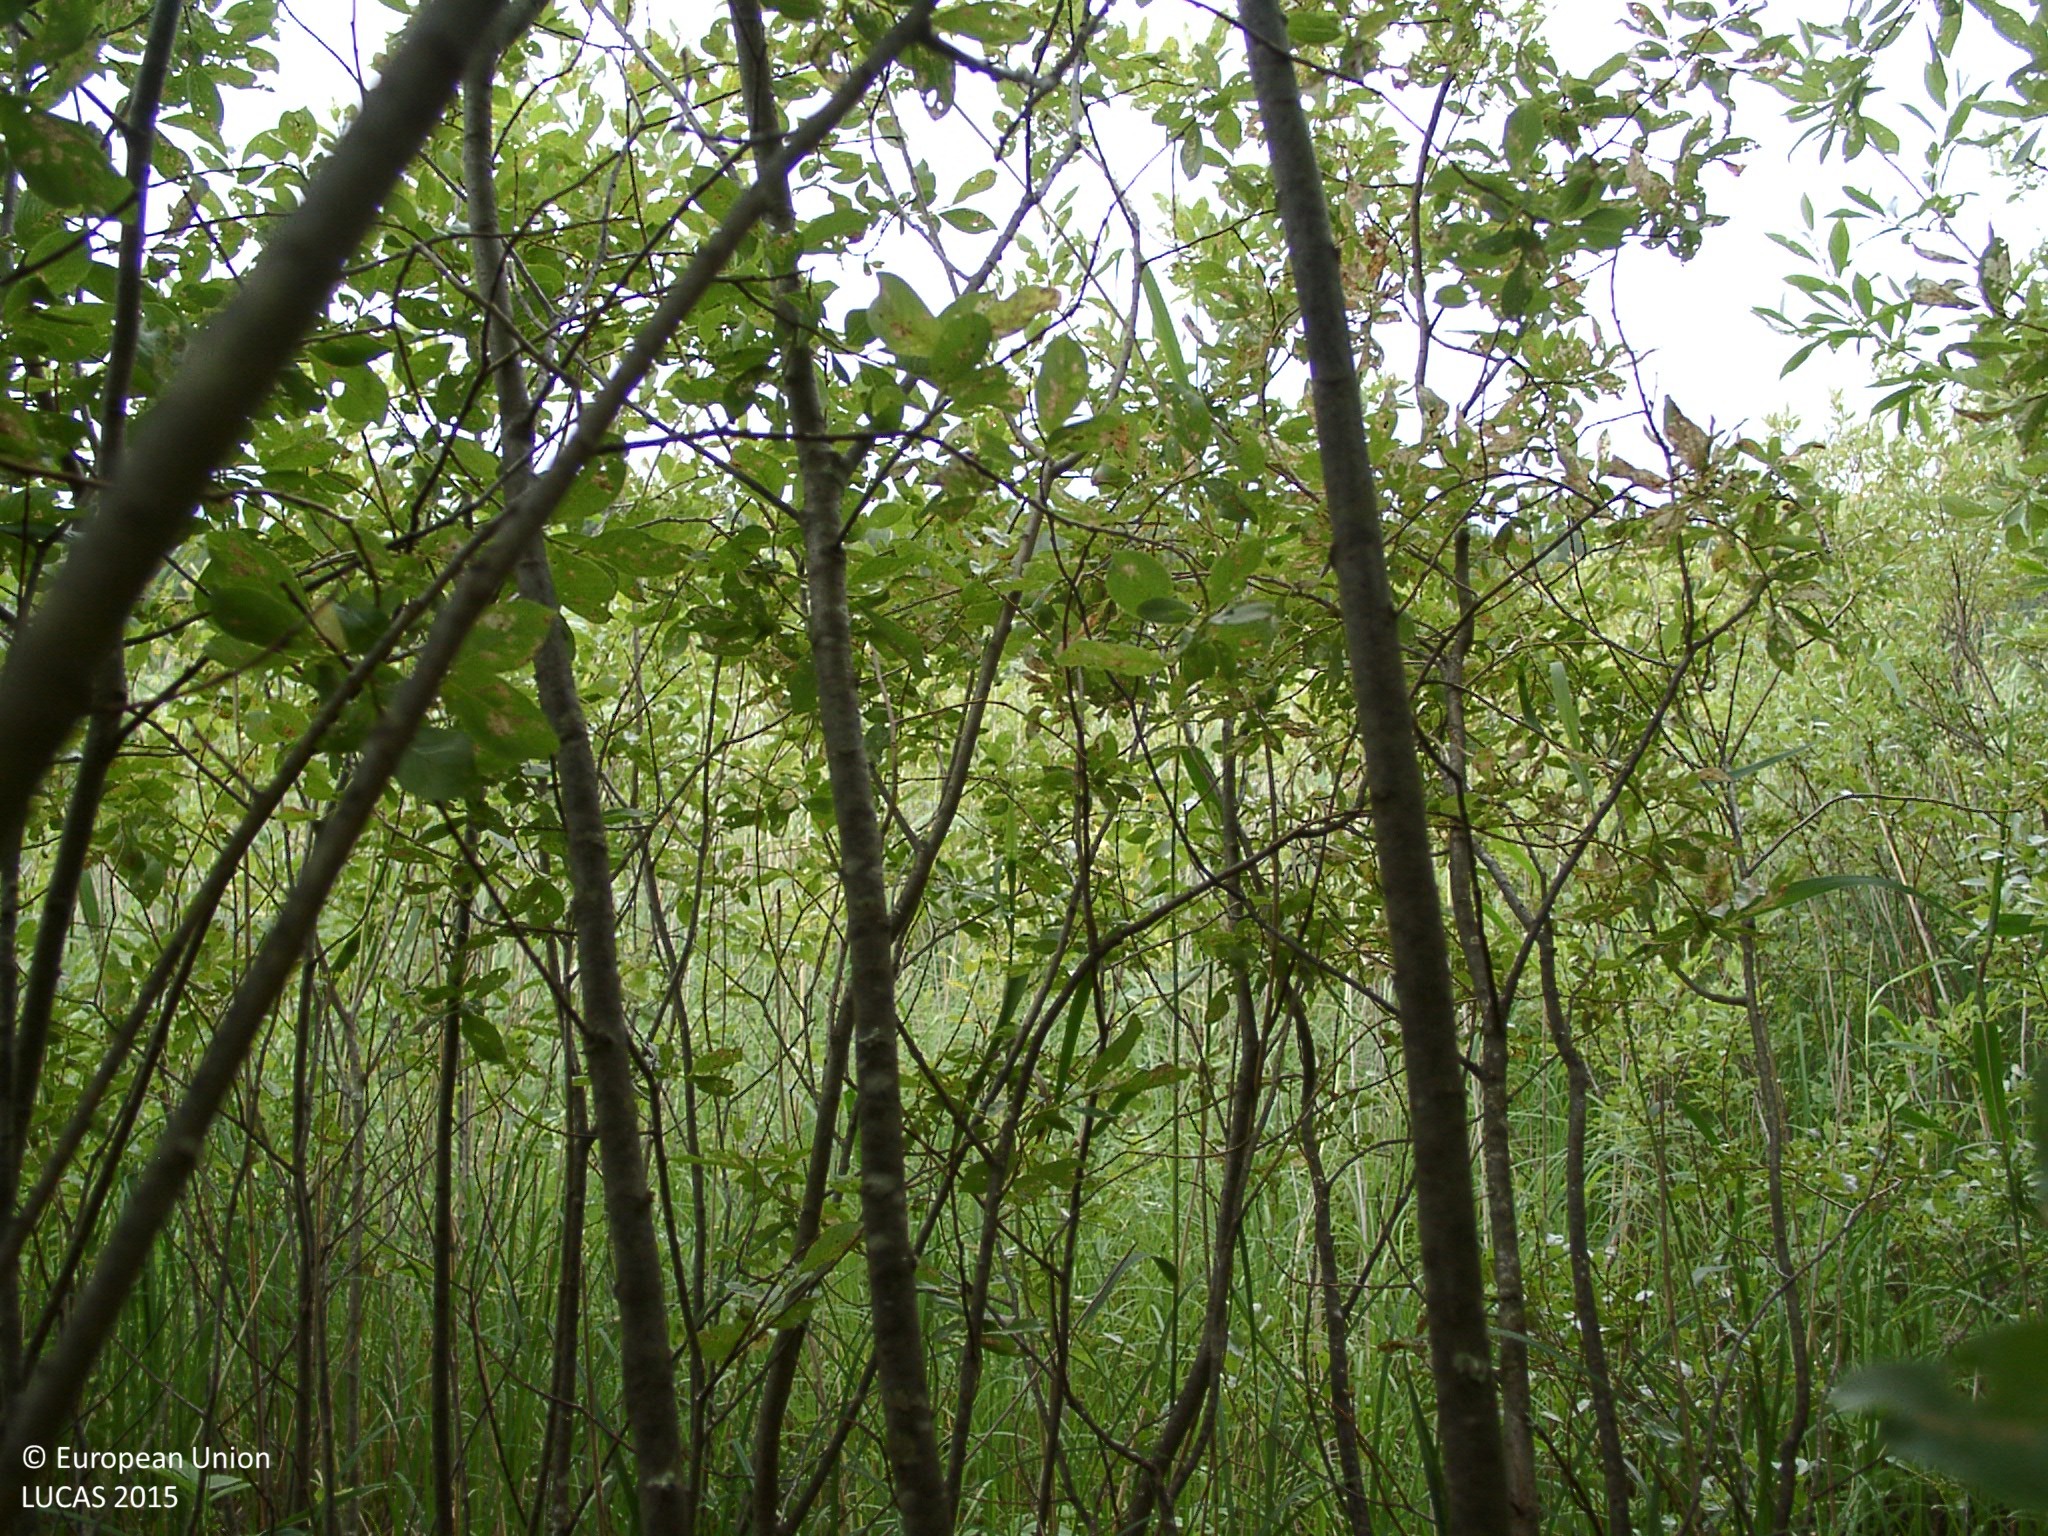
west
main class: Shrubland
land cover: Shrubland without tree cover
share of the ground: 50 - 75 %
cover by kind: shrubs 50 %, herbaceous plants 50 %
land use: Semi-natural and natural areas not in use
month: July
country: FI
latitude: 62.2903
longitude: 26.1101
